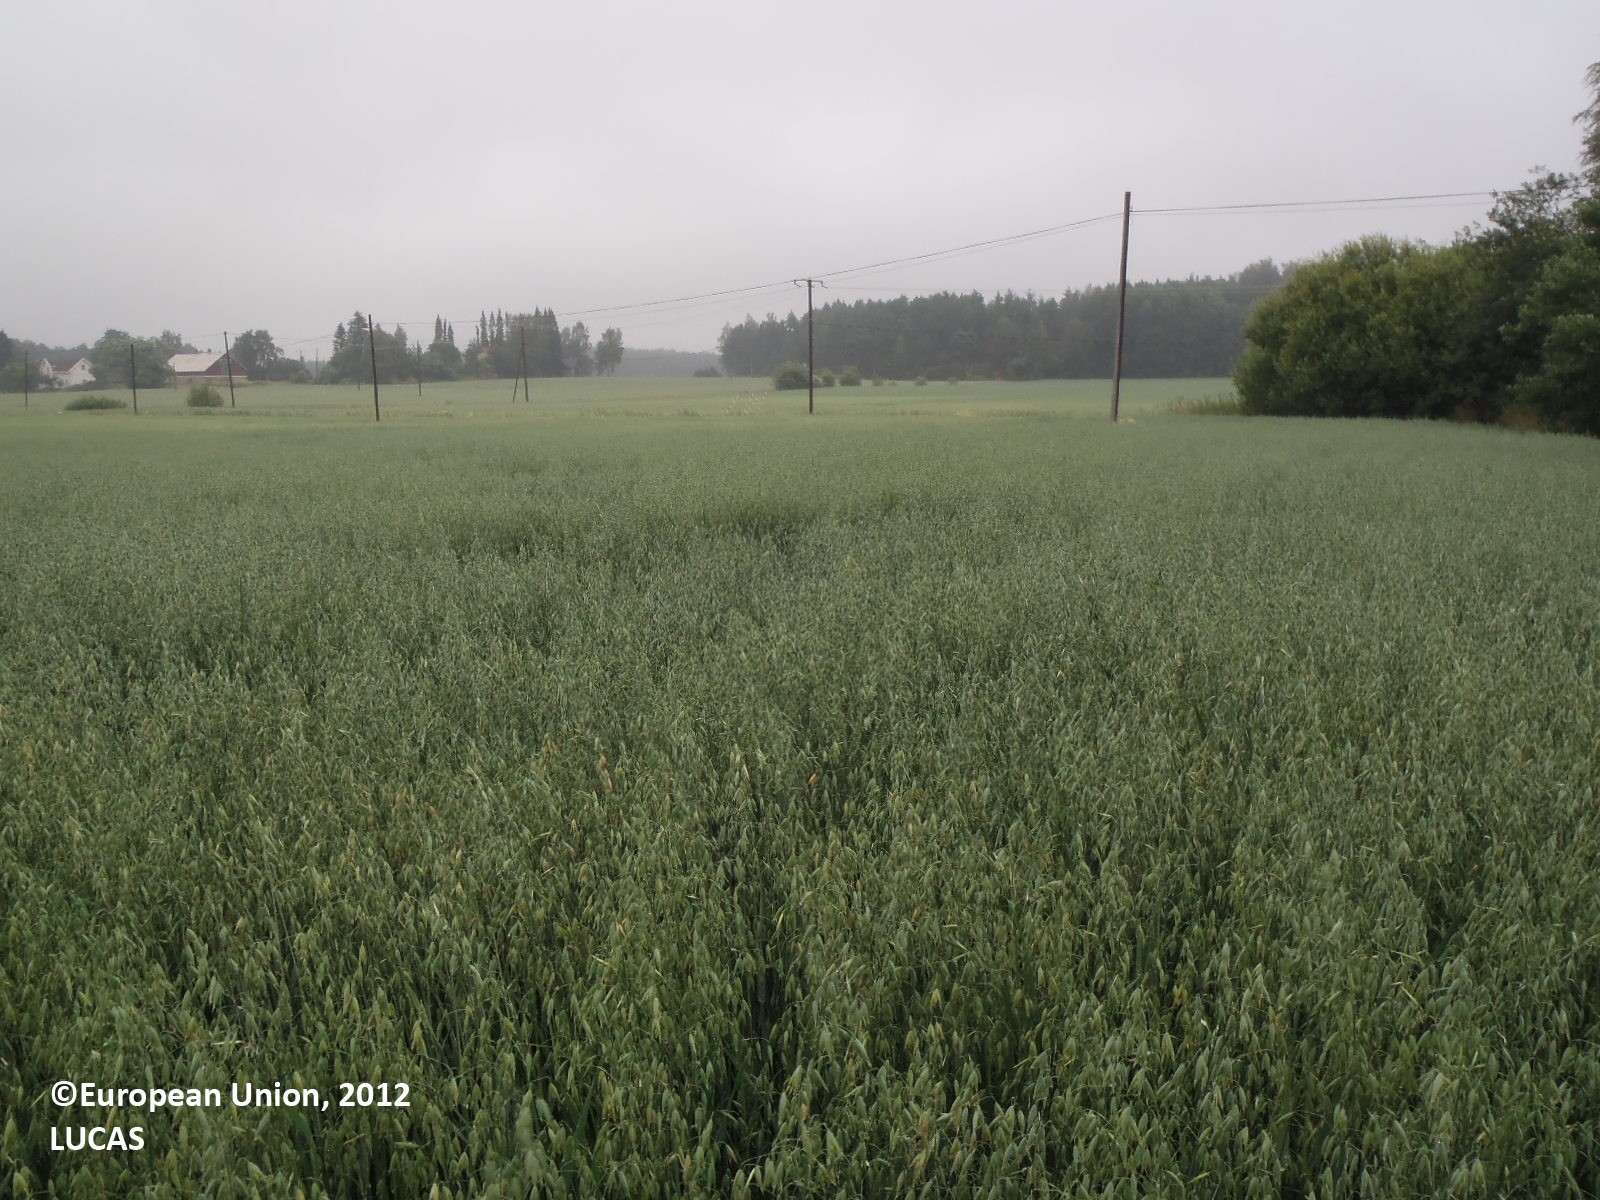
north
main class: Cropland
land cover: Oats
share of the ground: > 75 %
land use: Agriculture (excluding fallow land and kitchen gardens)
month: July
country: FI
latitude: 60.6896
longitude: 21.7605
